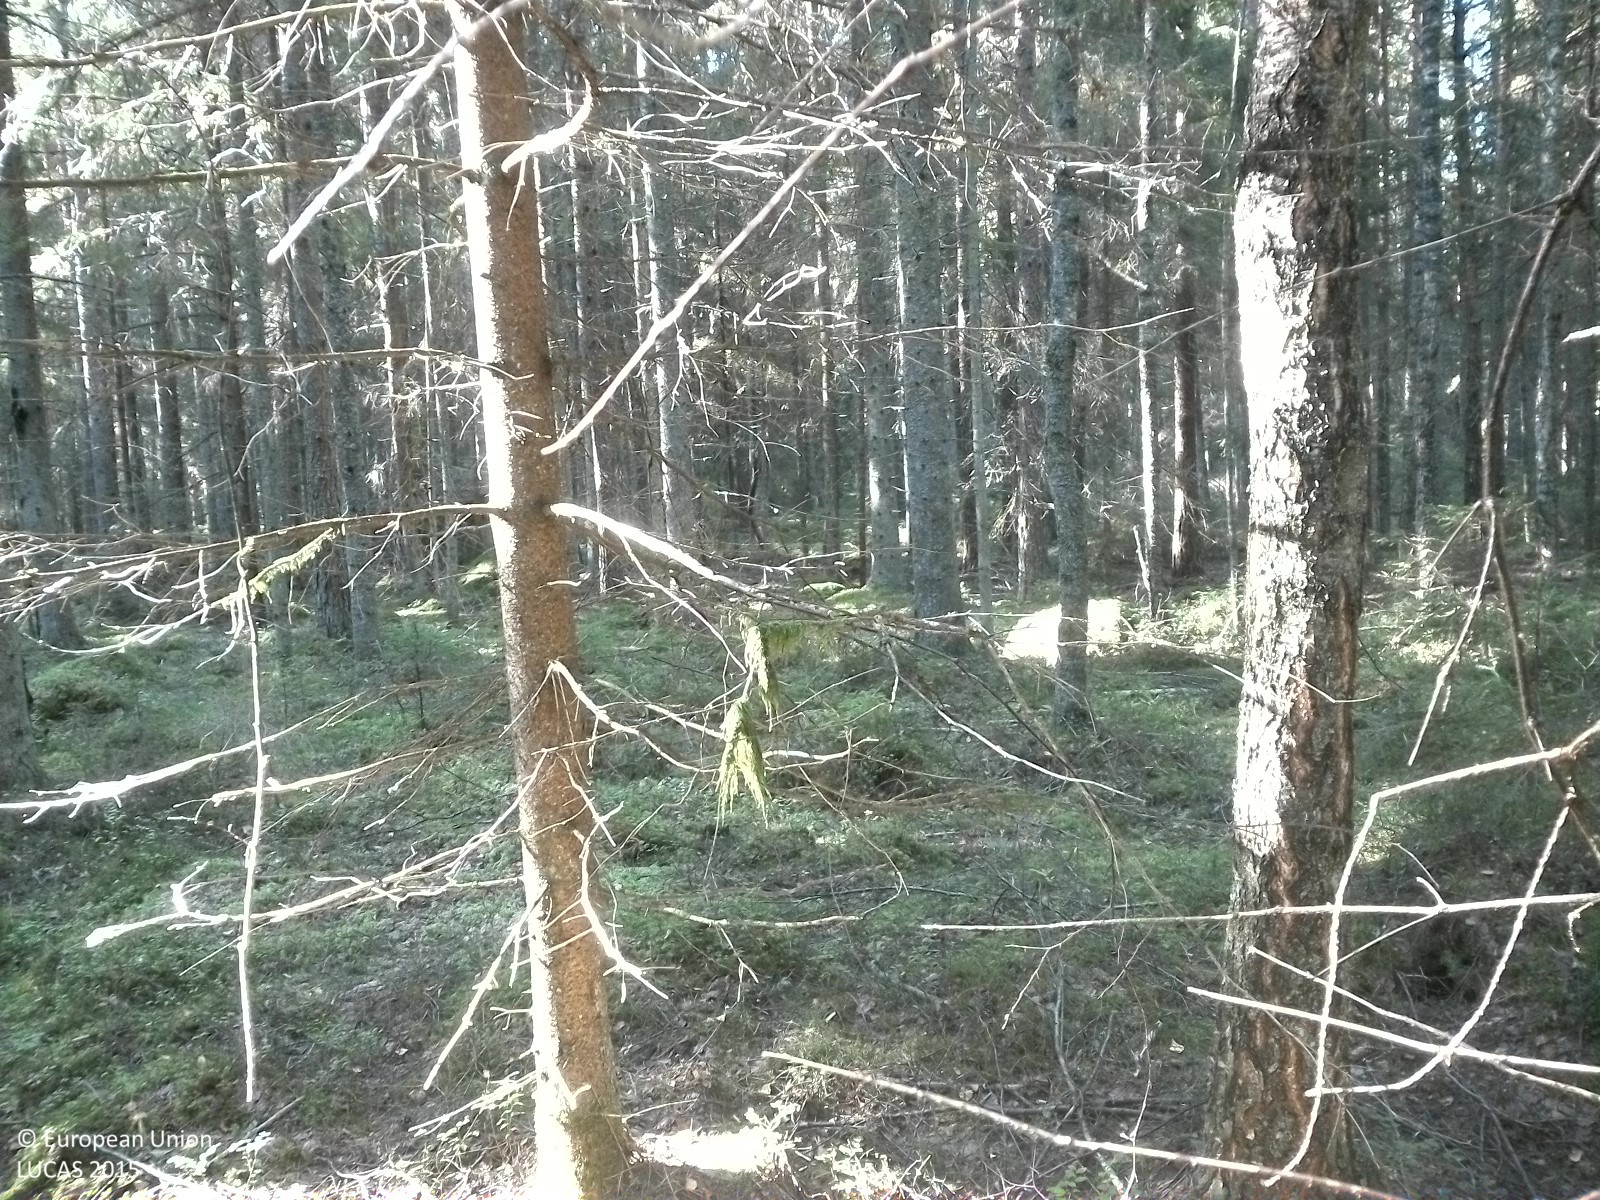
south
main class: Woodland
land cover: Other coniferous woodland
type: boreal forest
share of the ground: 50 - 75 %
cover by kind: coniferous forest trees 60 %, lichens and mosses 20 %, herbaceous plants 15 %, broadleaved forest trees 5 %
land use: Forestry
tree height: > 5 m
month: August
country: SE
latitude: 59.2961
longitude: 15.0659
